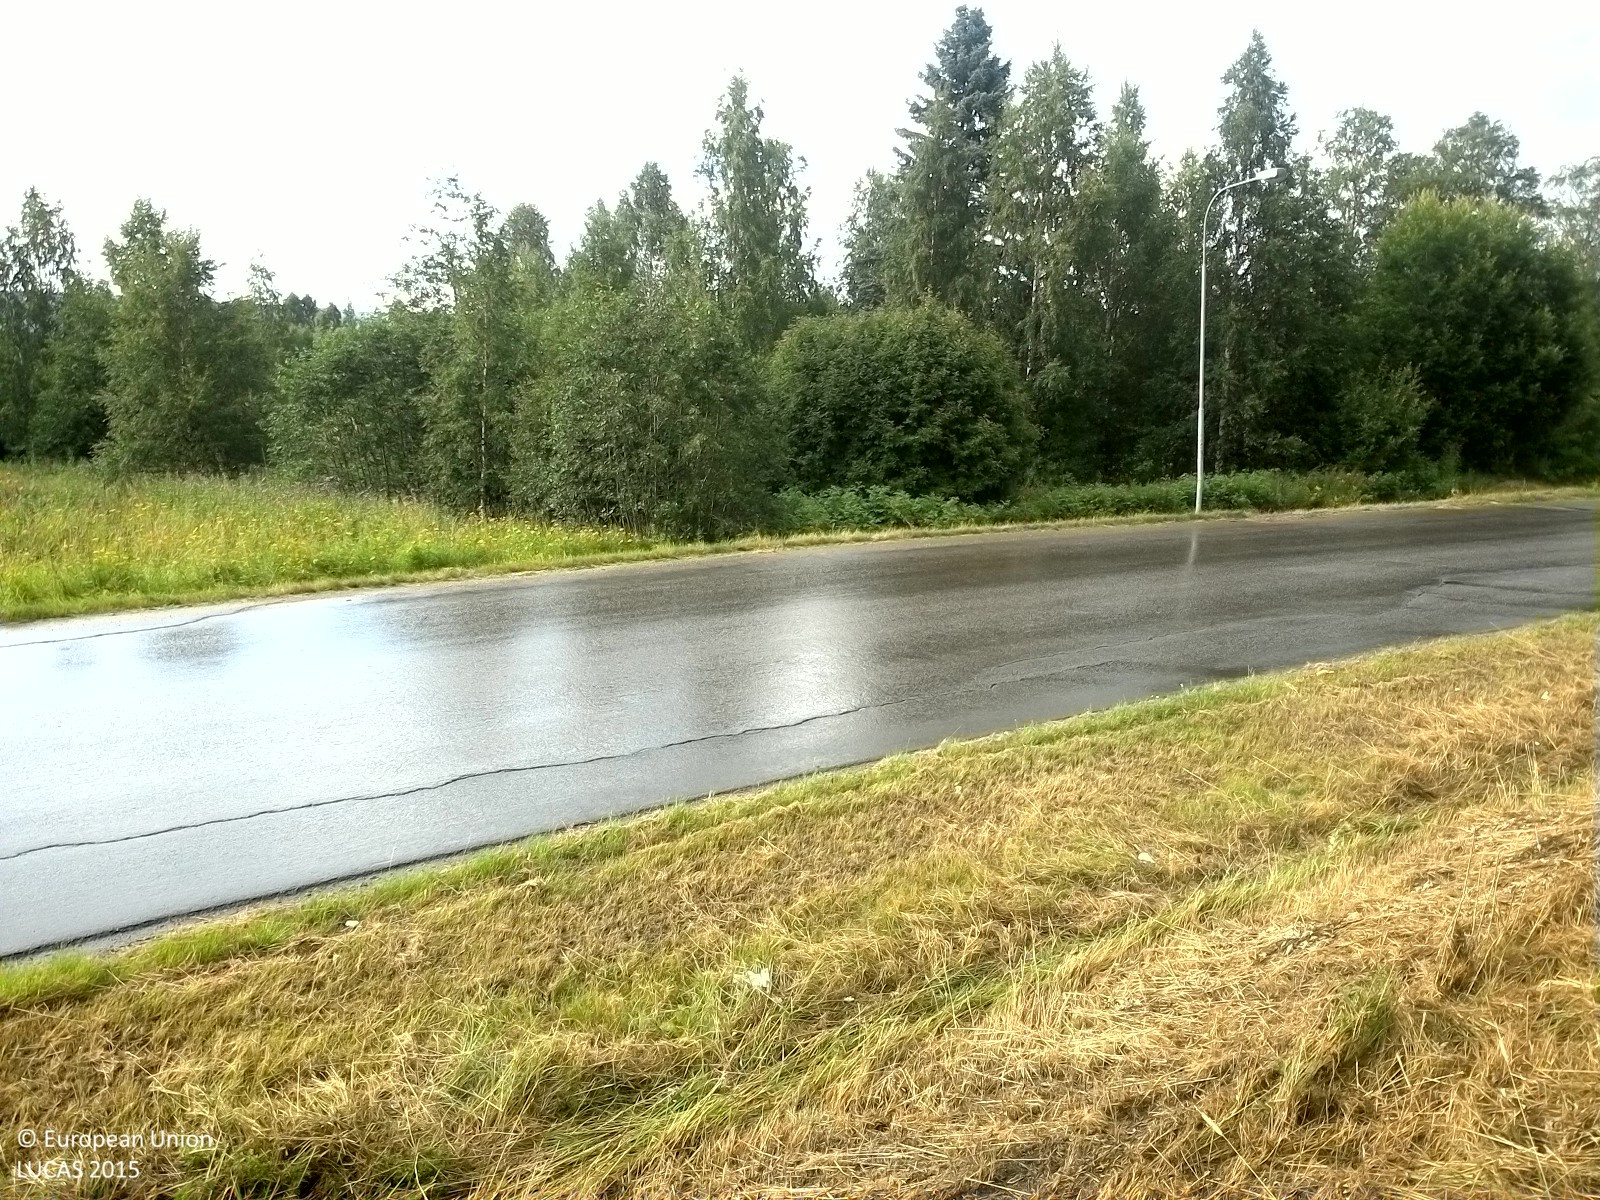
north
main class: Grassland
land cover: Grassland without tree/shrub cover
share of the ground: > 75 %
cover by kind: herbaceous plants 100 %
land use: Abandoned areas
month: August
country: SE
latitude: 62.4021
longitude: 17.2362
